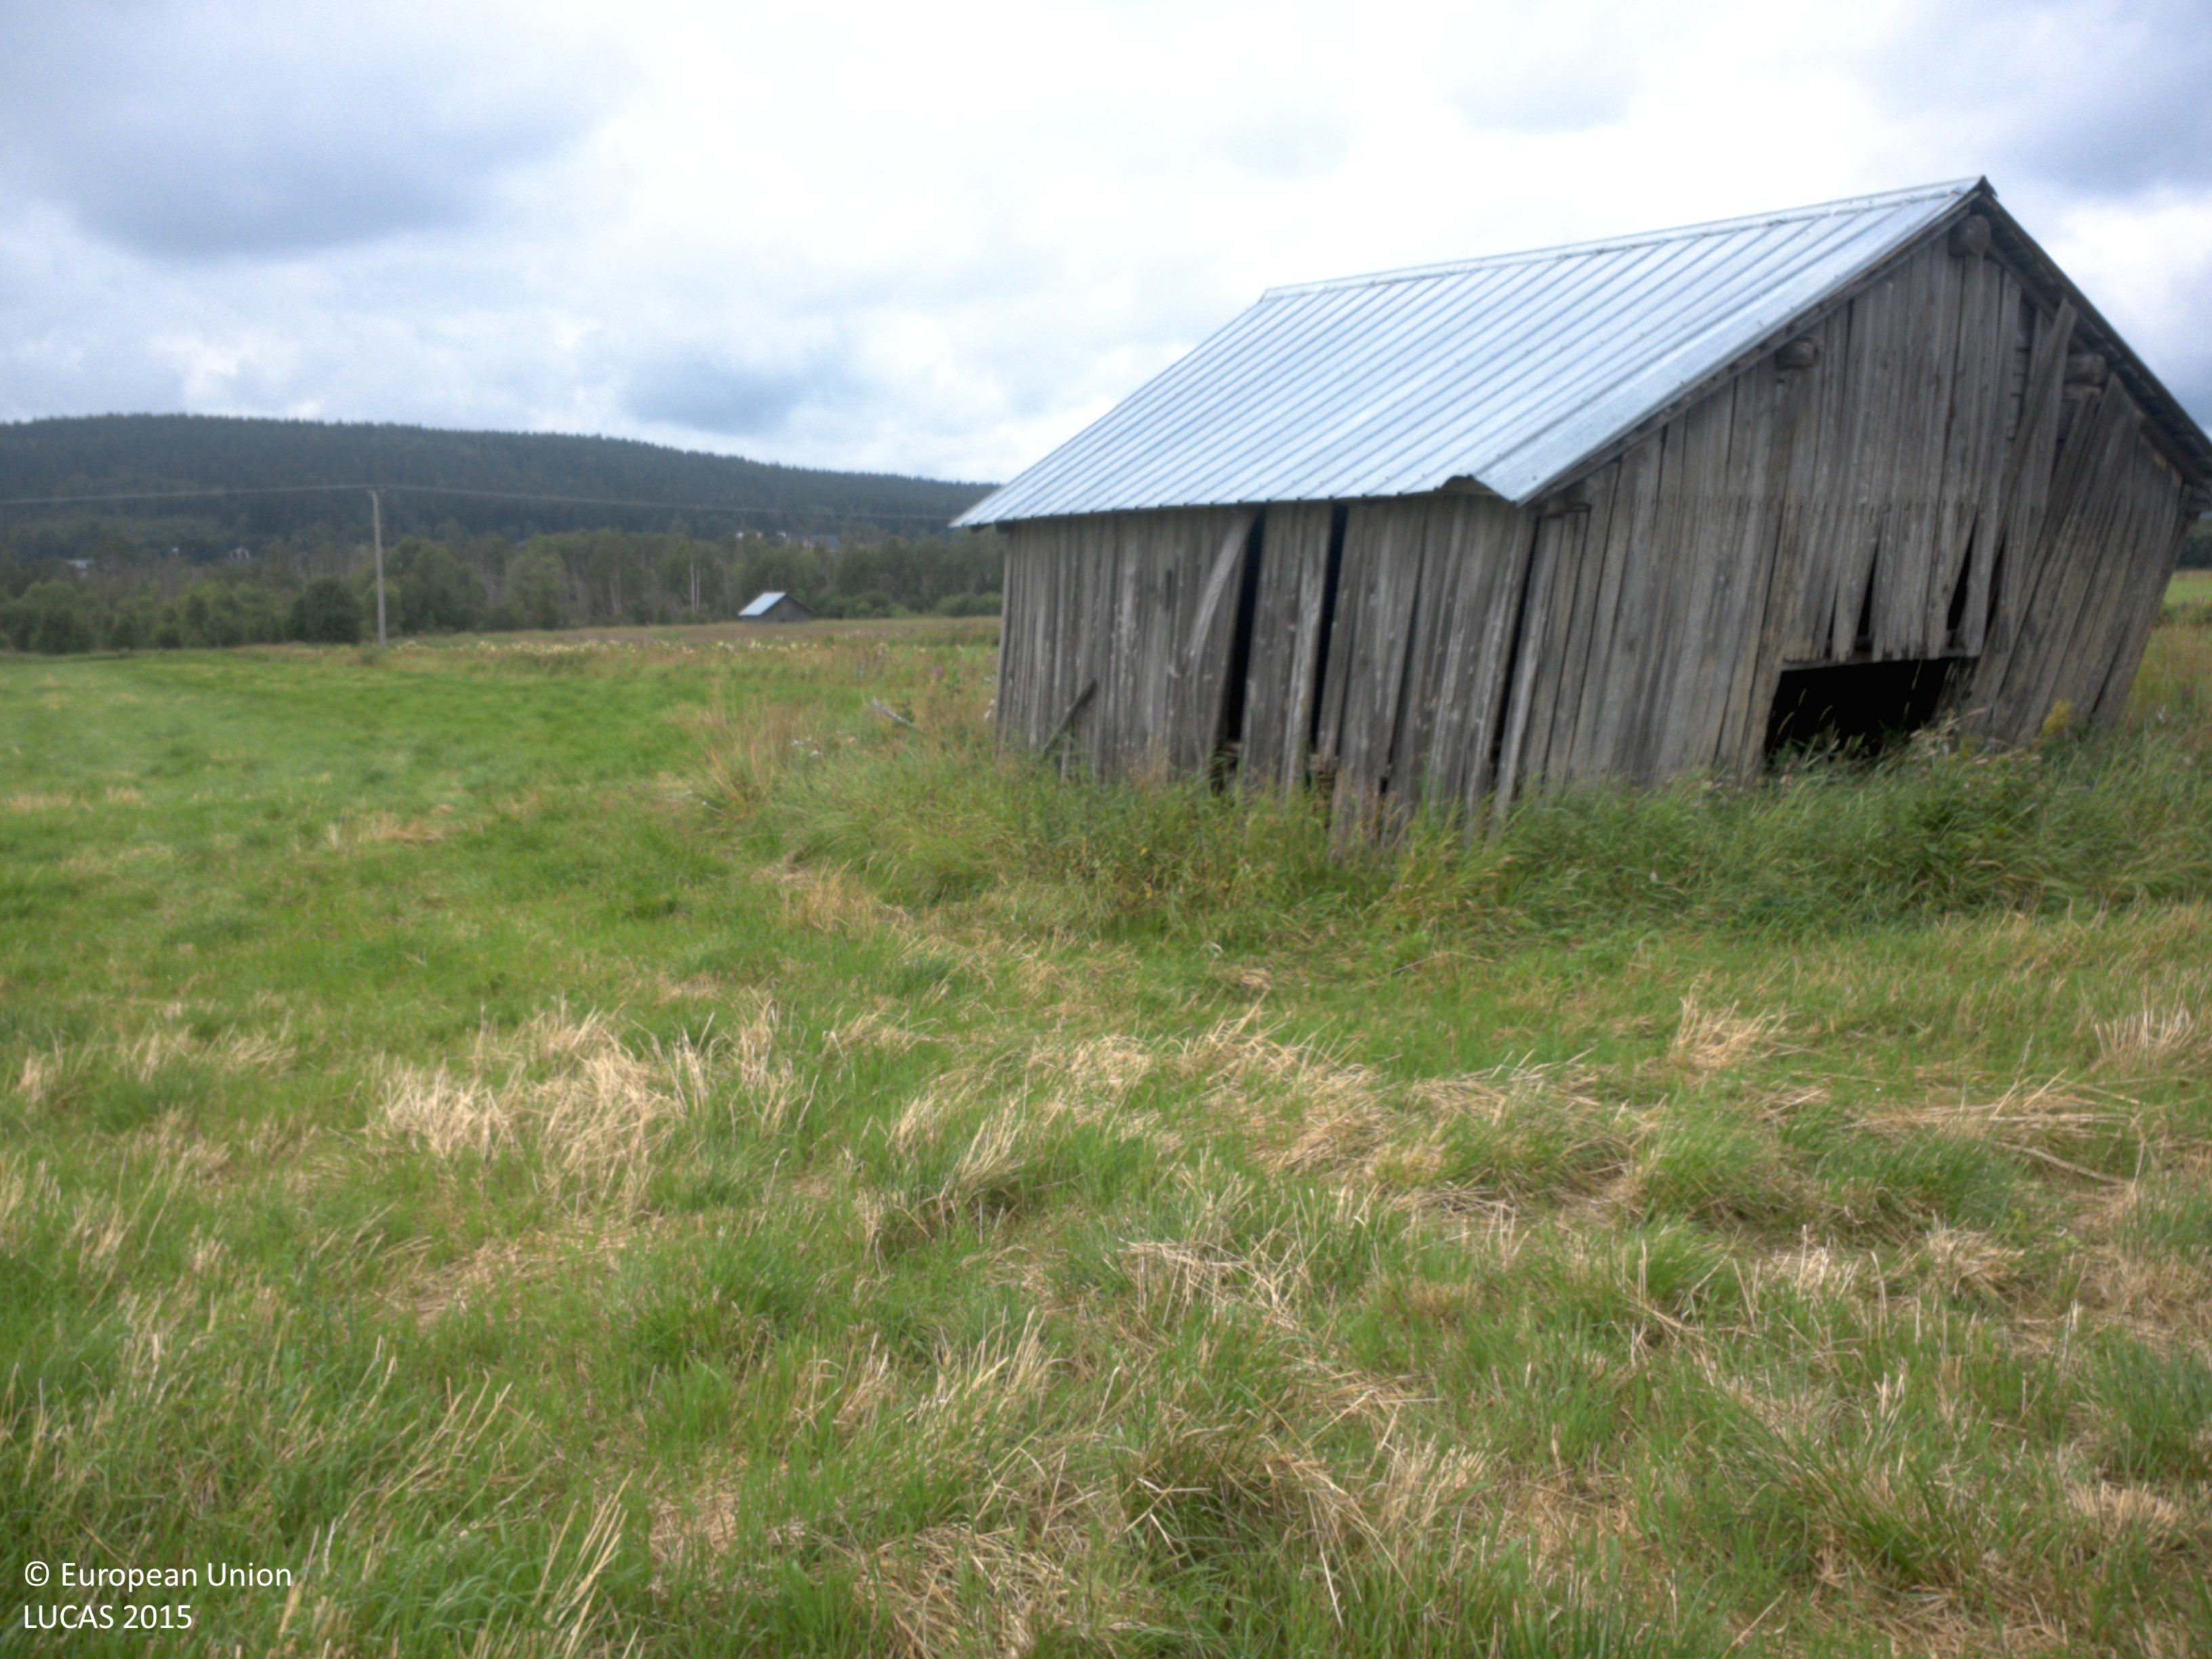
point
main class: Grassland
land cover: Spontaneously vegetated surfaces
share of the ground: > 75 %
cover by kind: herbaceous plants 100 %
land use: Agriculture (excluding fallow land and kitchen gardens)
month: August
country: SE
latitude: 63.7810
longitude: 19.8596
